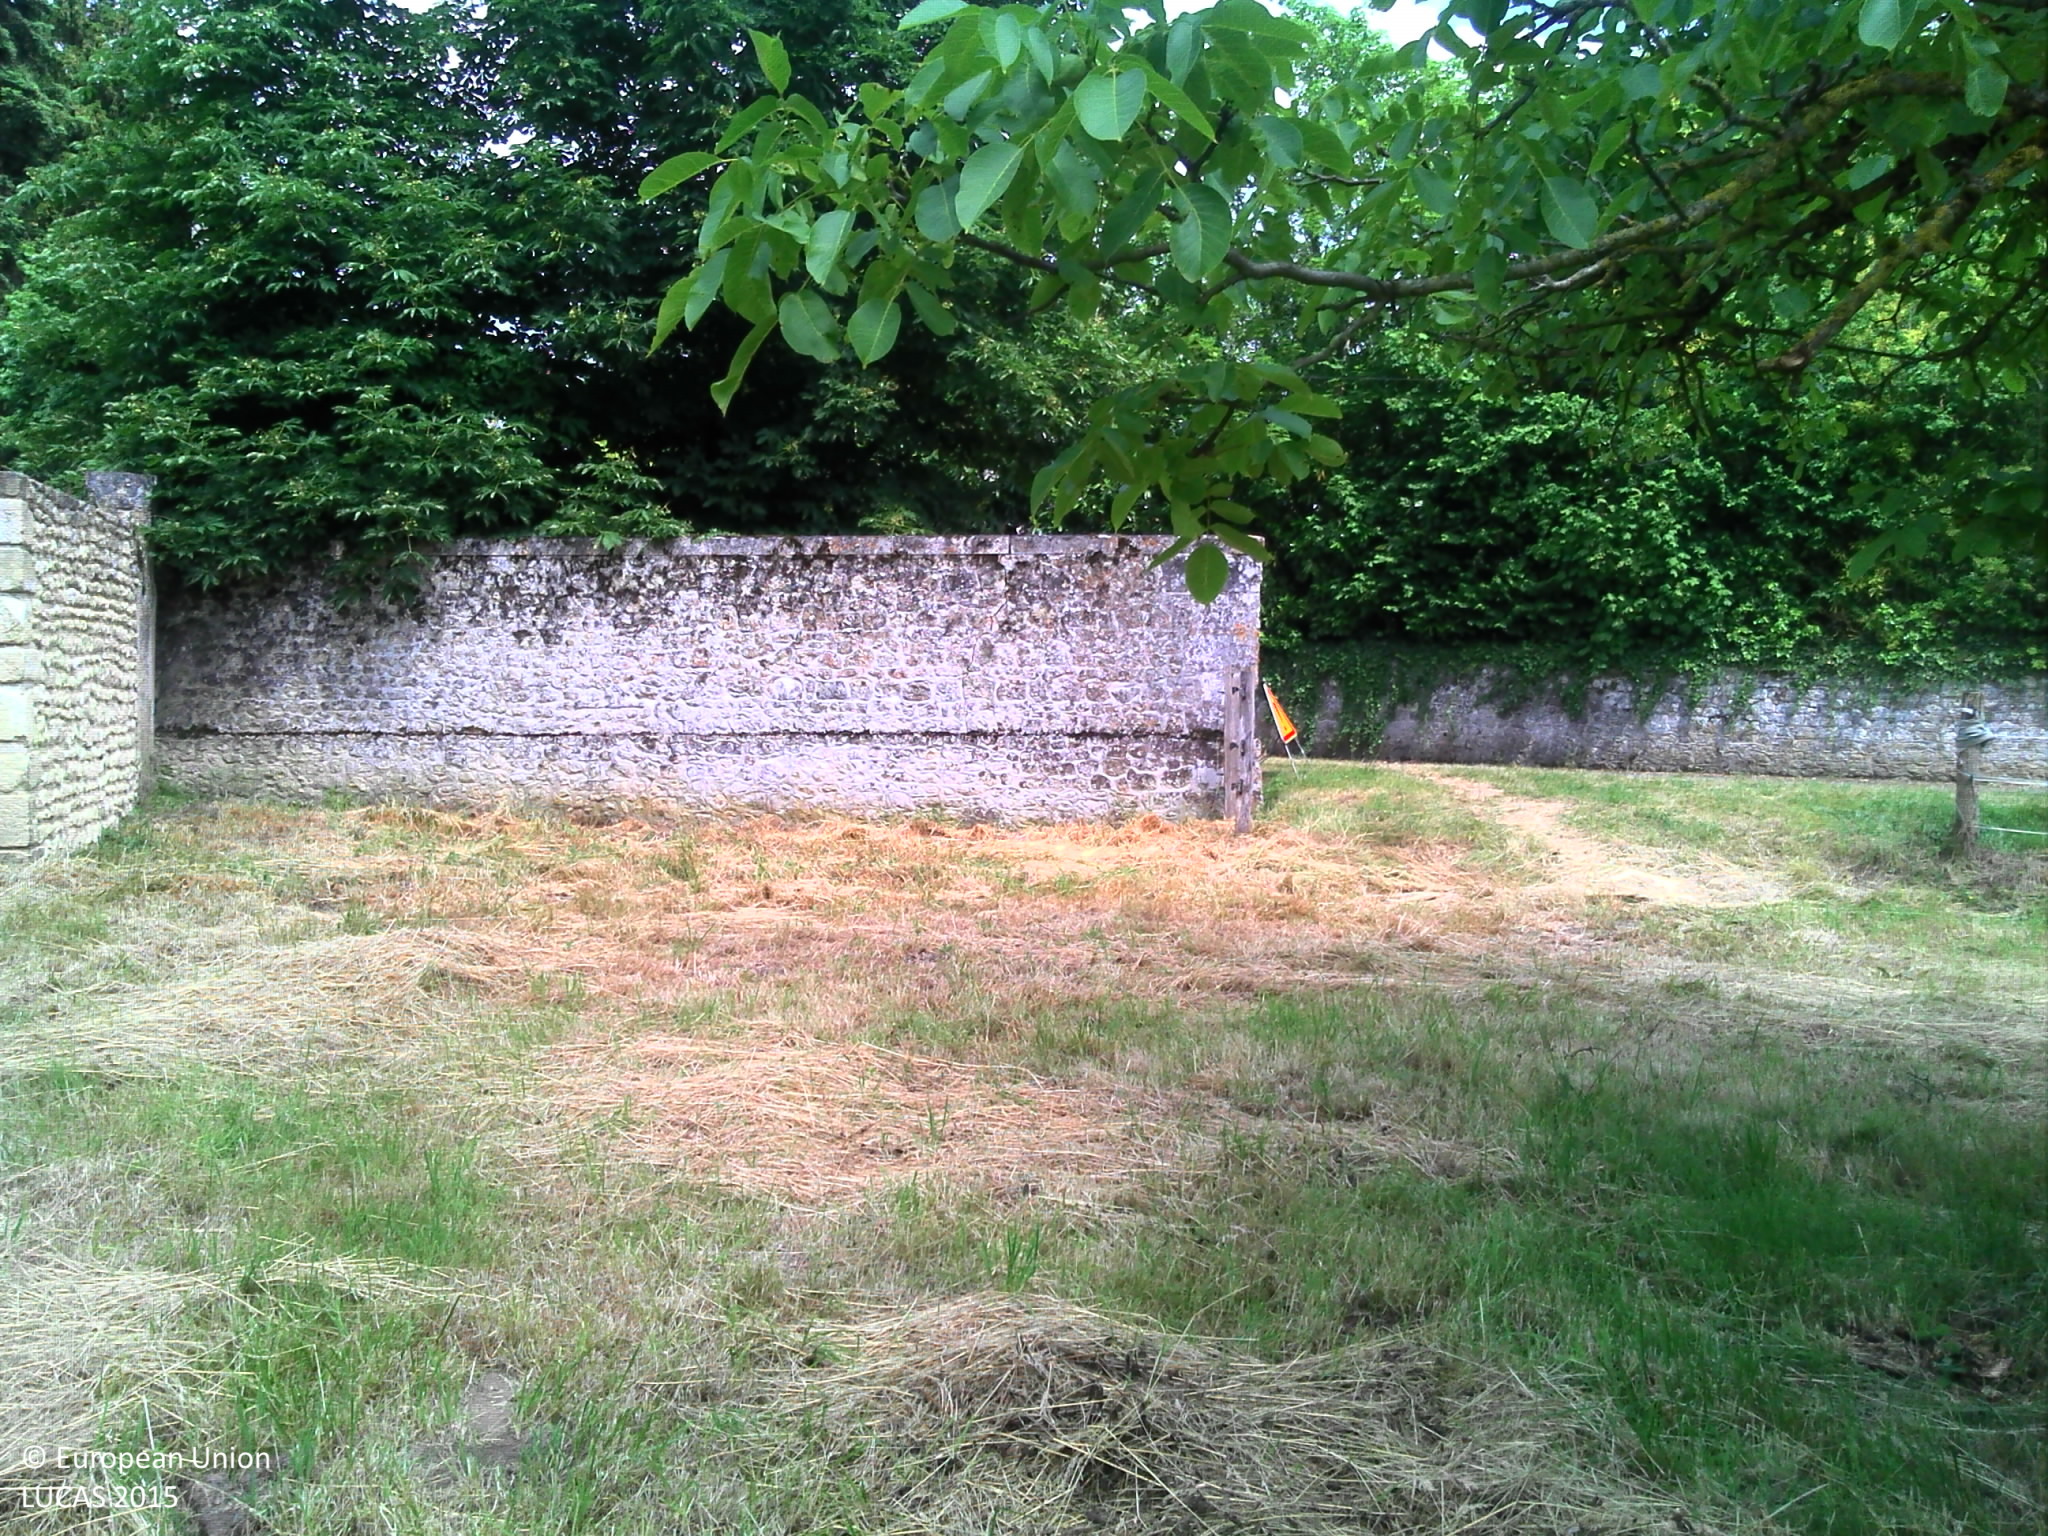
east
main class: Grassland
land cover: Grassland with sparse tree/shrub cover
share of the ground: > 75 %
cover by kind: herbaceous plants 95 %, broadleaved forest trees 5 %
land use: Residential
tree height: > 5 m
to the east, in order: Grassland with sparse tree/shrub cover; Dry stone walls; Grassland with sparse tree/shrub cover; Fences; Grass margins; Ditches and canals; Artificial constructions in urban areas
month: June
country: FR
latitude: 47.0818
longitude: 1.0677
